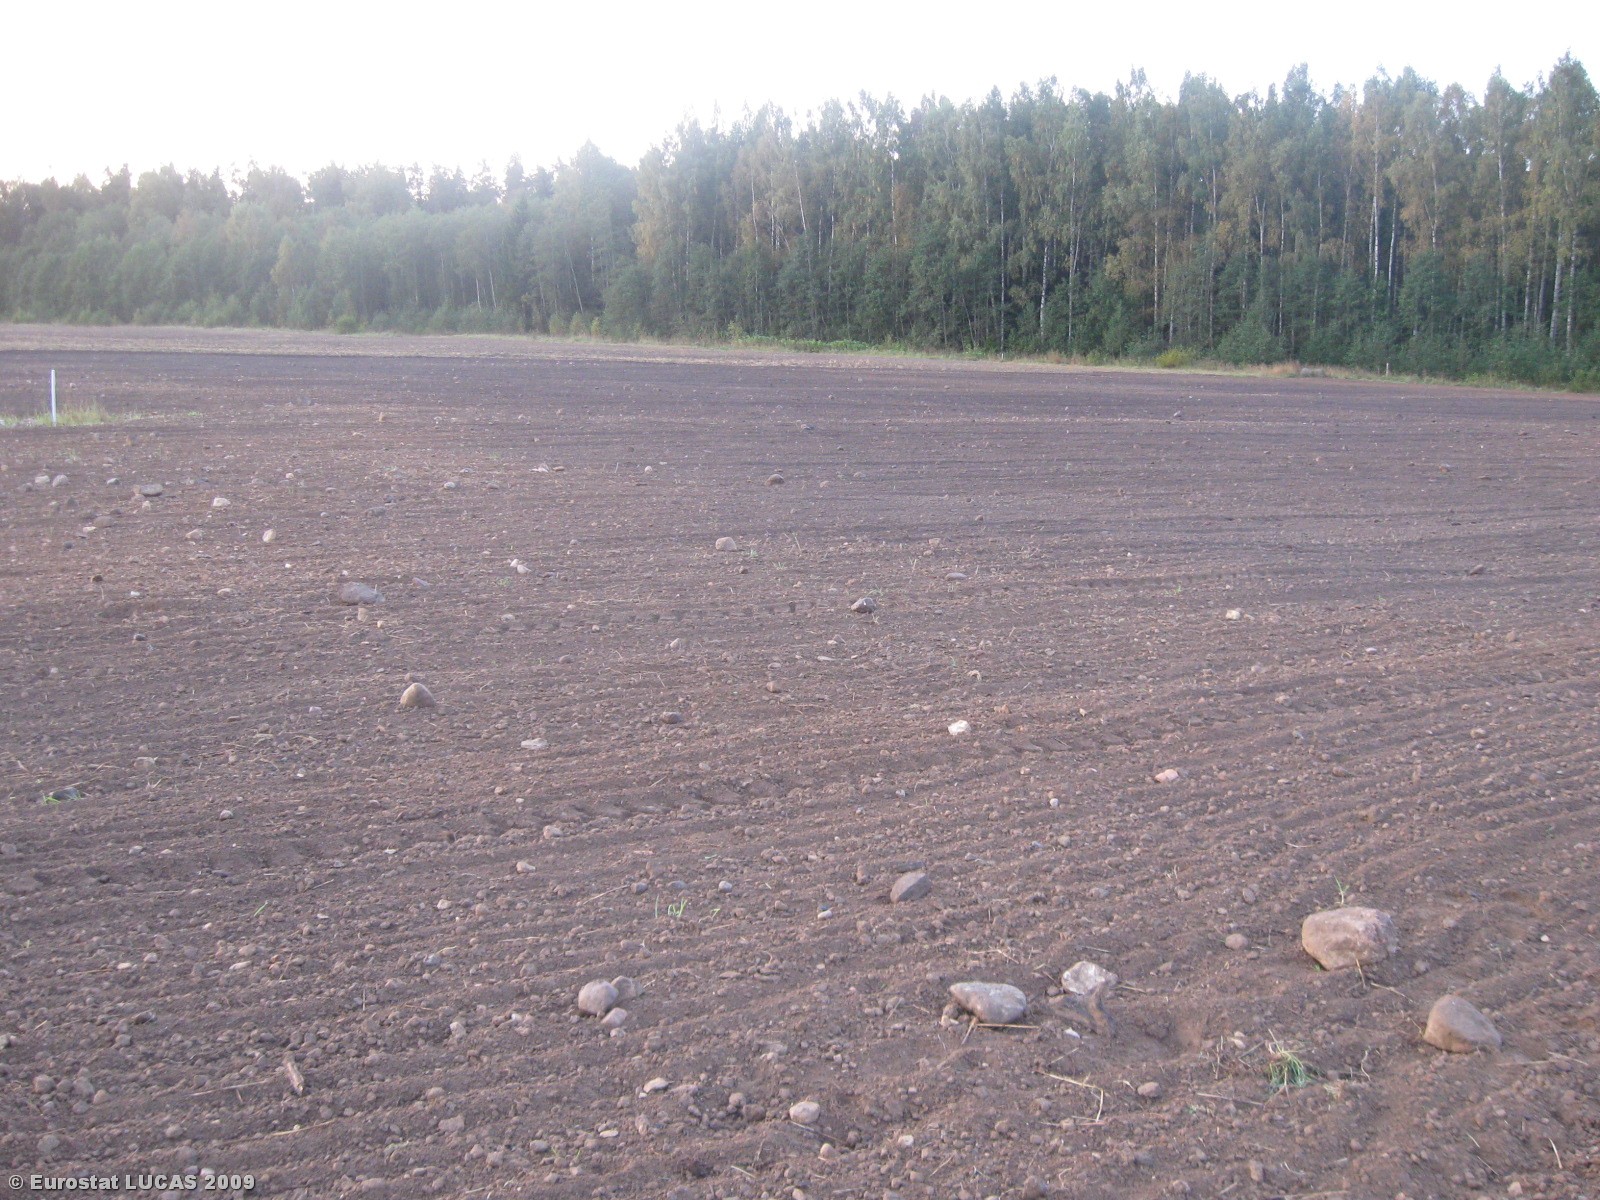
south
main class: Cropland
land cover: Rye
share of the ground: < 10 %
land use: Agriculture (excluding fallow land and kitchen gardens)
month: September
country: LT
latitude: 56.1685
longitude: 25.2375
